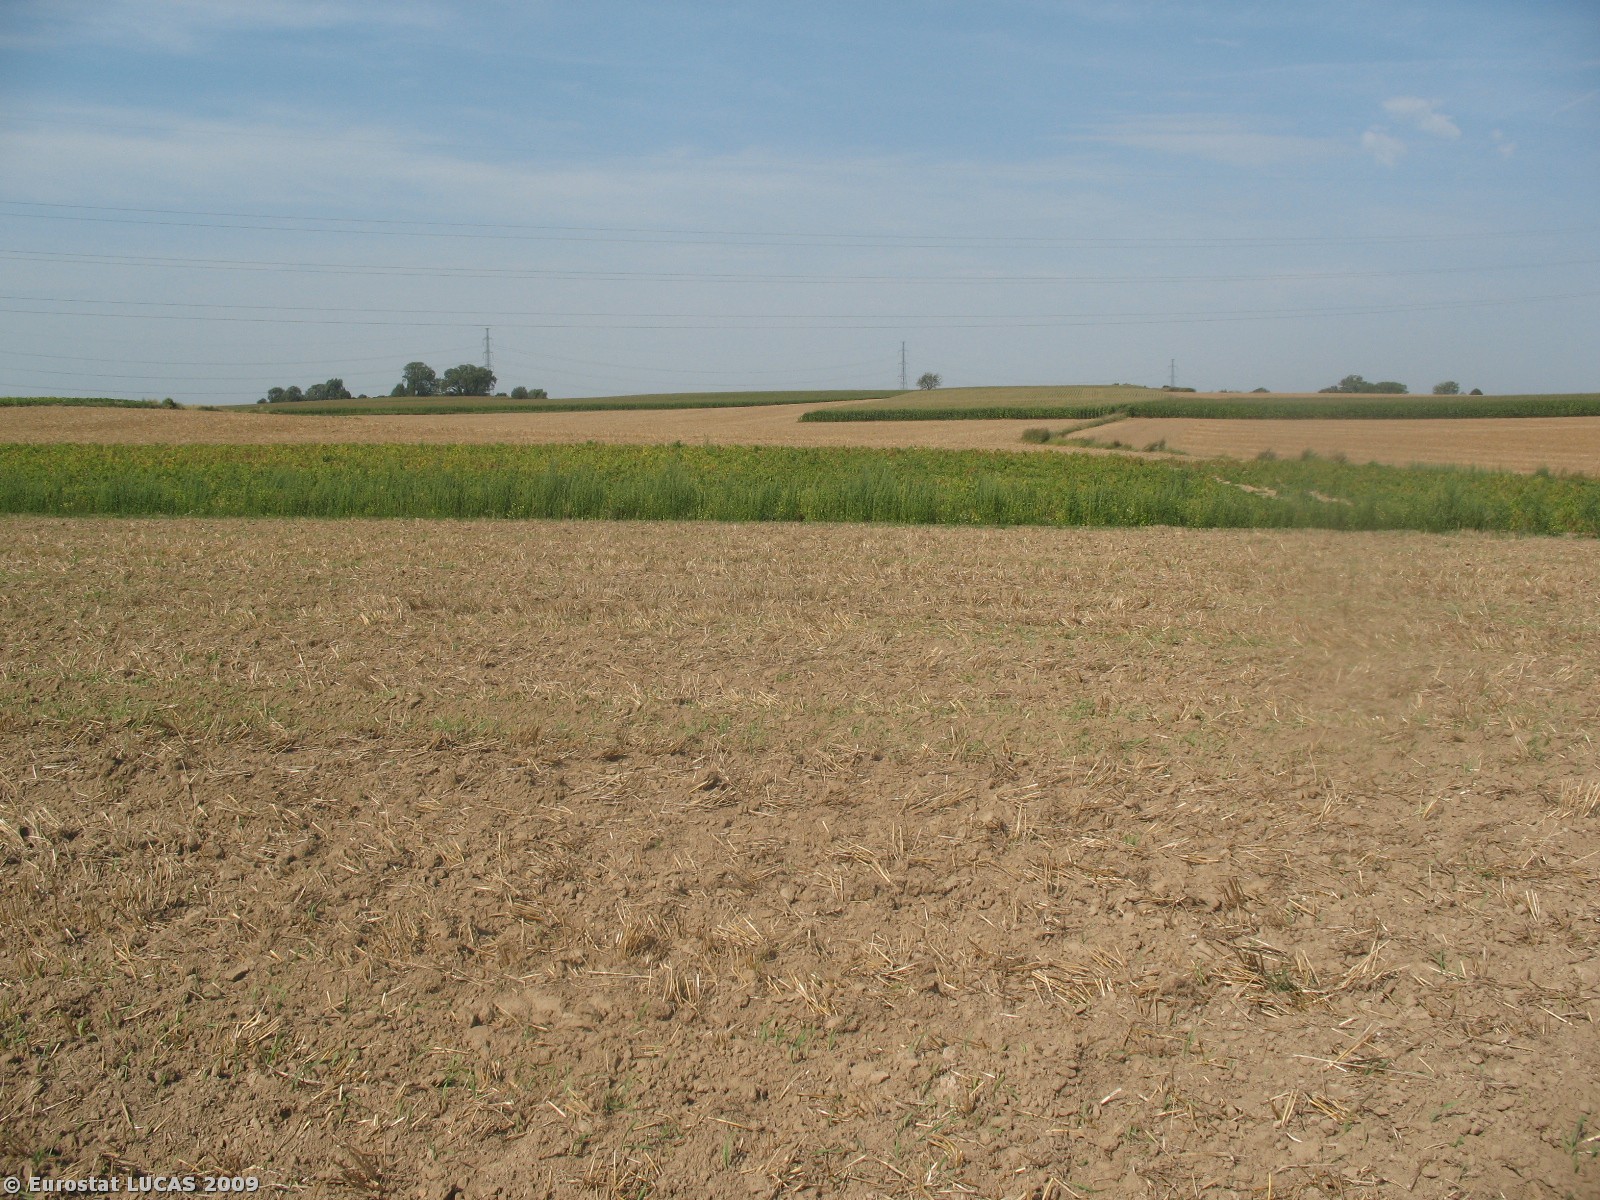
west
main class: Cropland
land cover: Common wheat
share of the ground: > 75 %
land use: Agriculture (excluding fallow land and kitchen gardens)
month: August
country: BE
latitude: 50.5303
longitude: 4.3383
